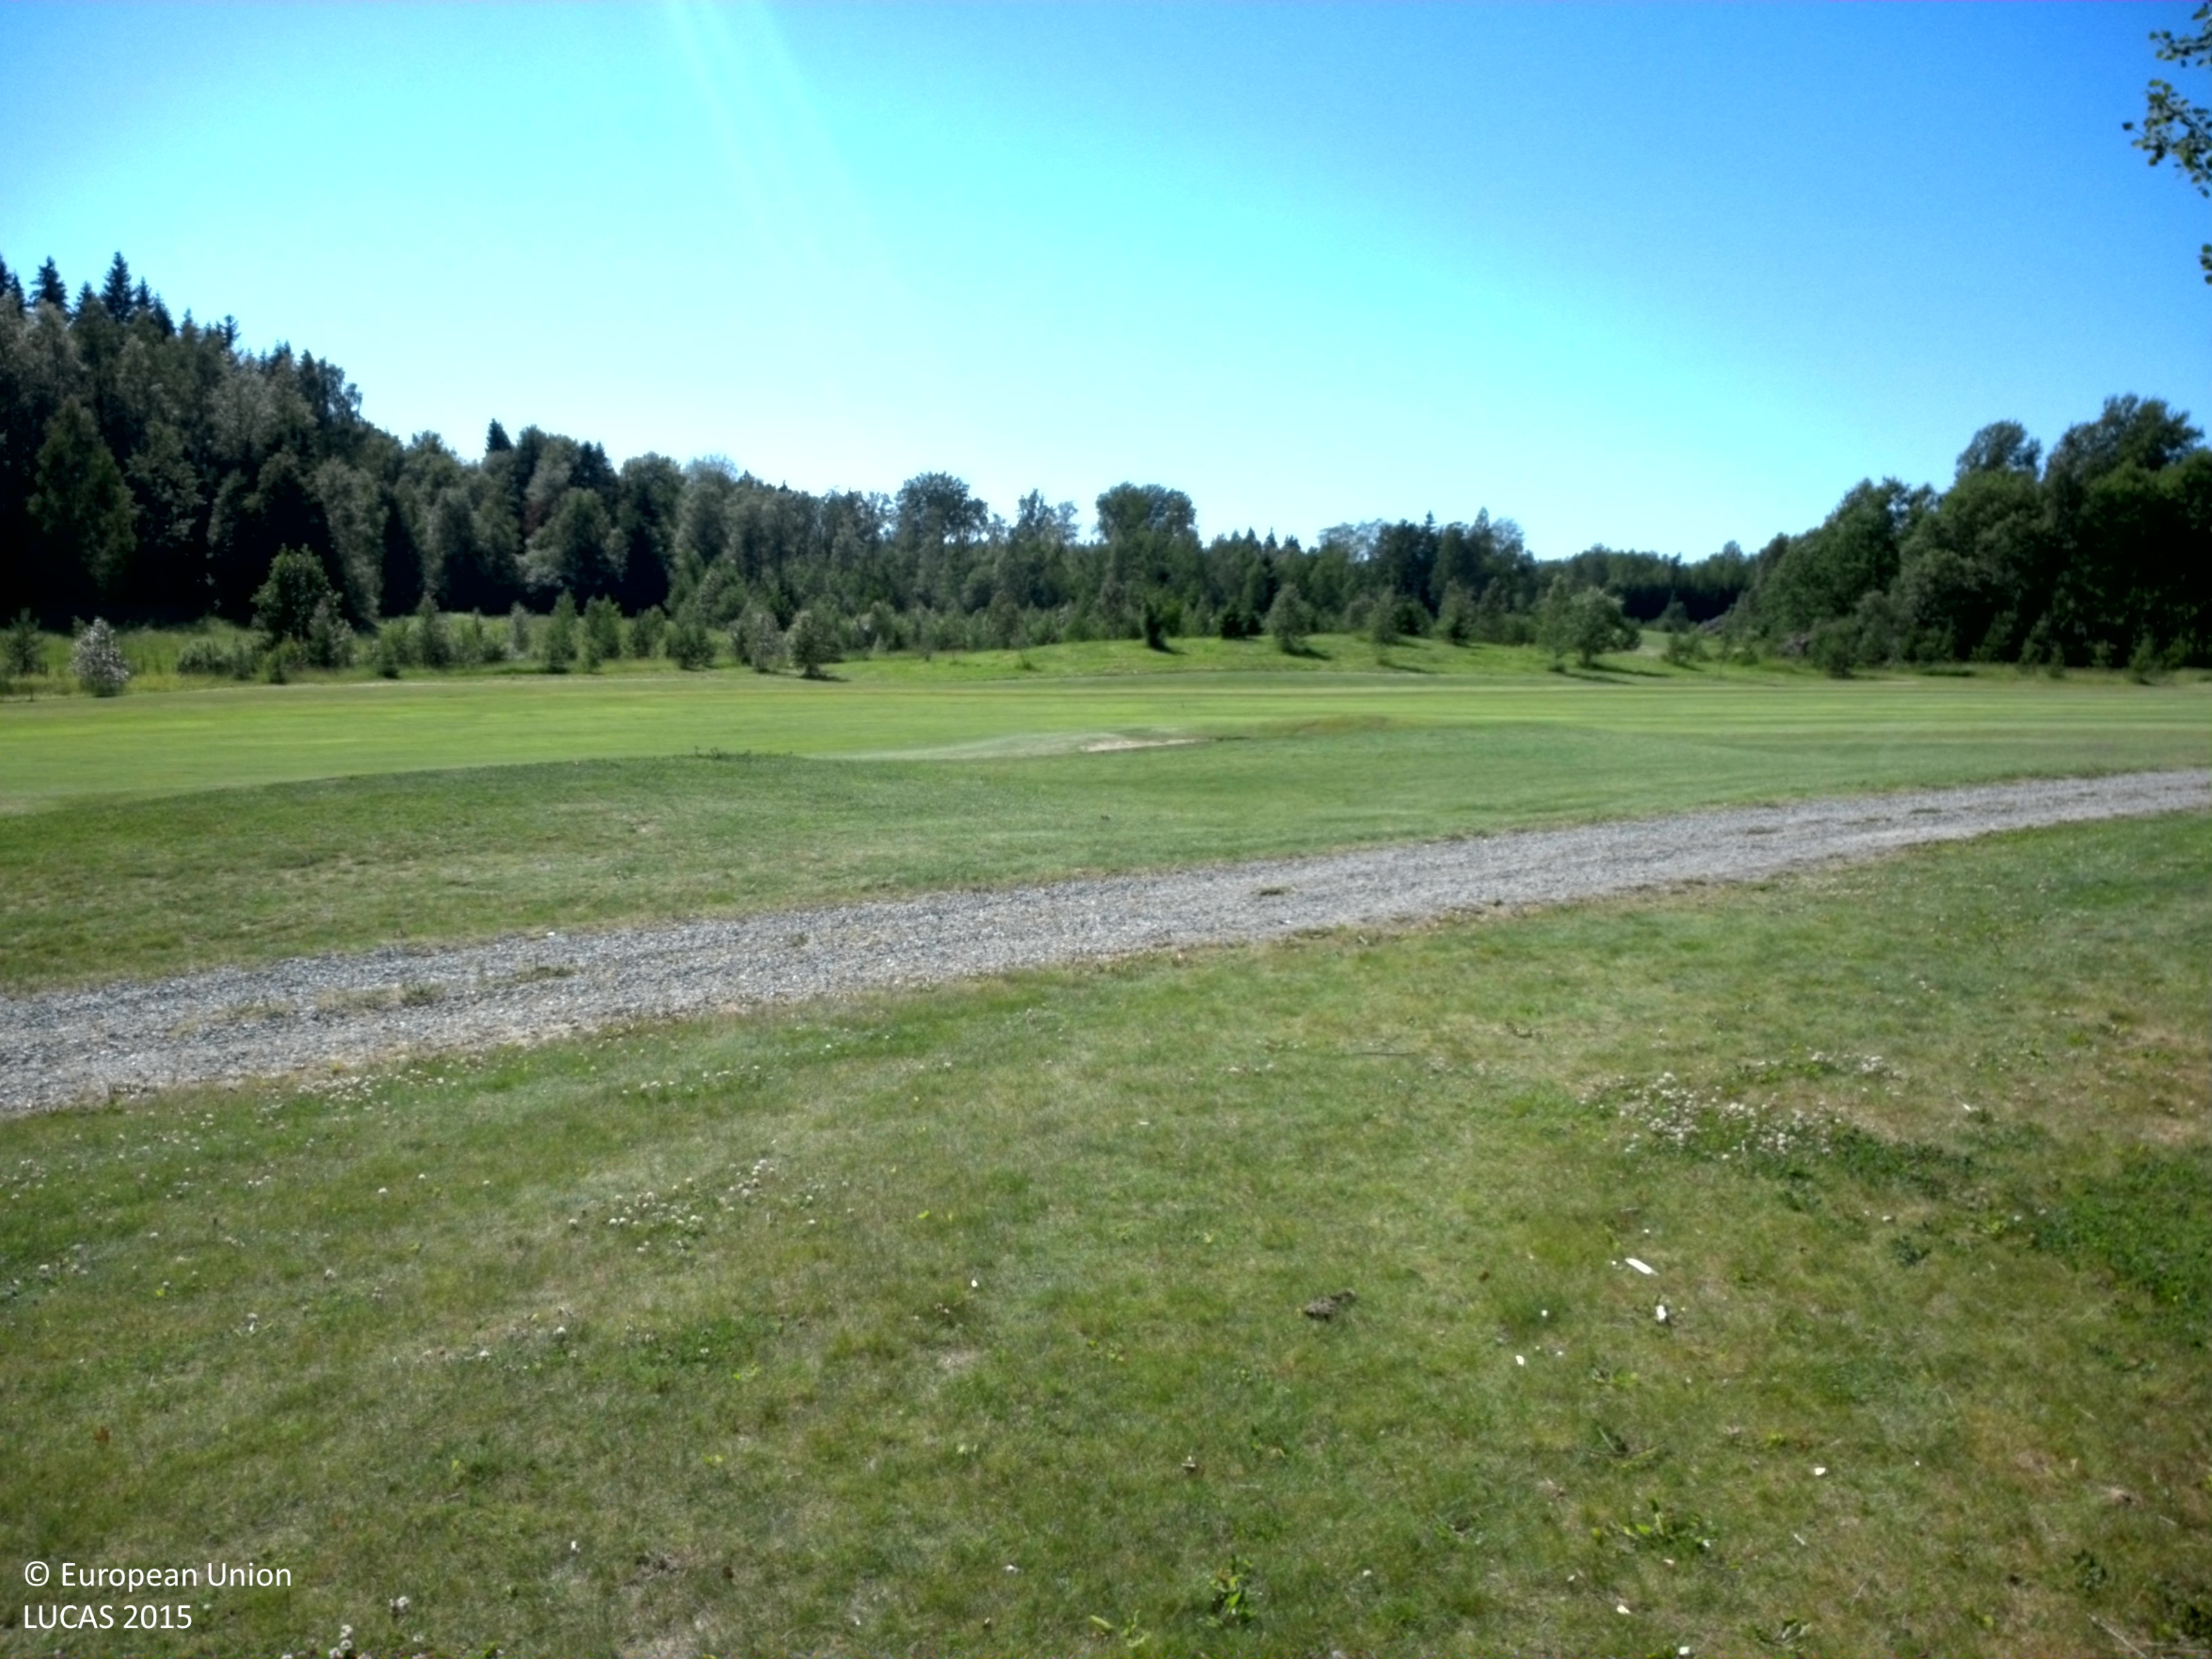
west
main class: Grassland
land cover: Grassland without tree/shrub cover
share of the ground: > 75 %
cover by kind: herbaceous plants 100 %
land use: Sport
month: July
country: SE
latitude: 59.9489
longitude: 16.7047
